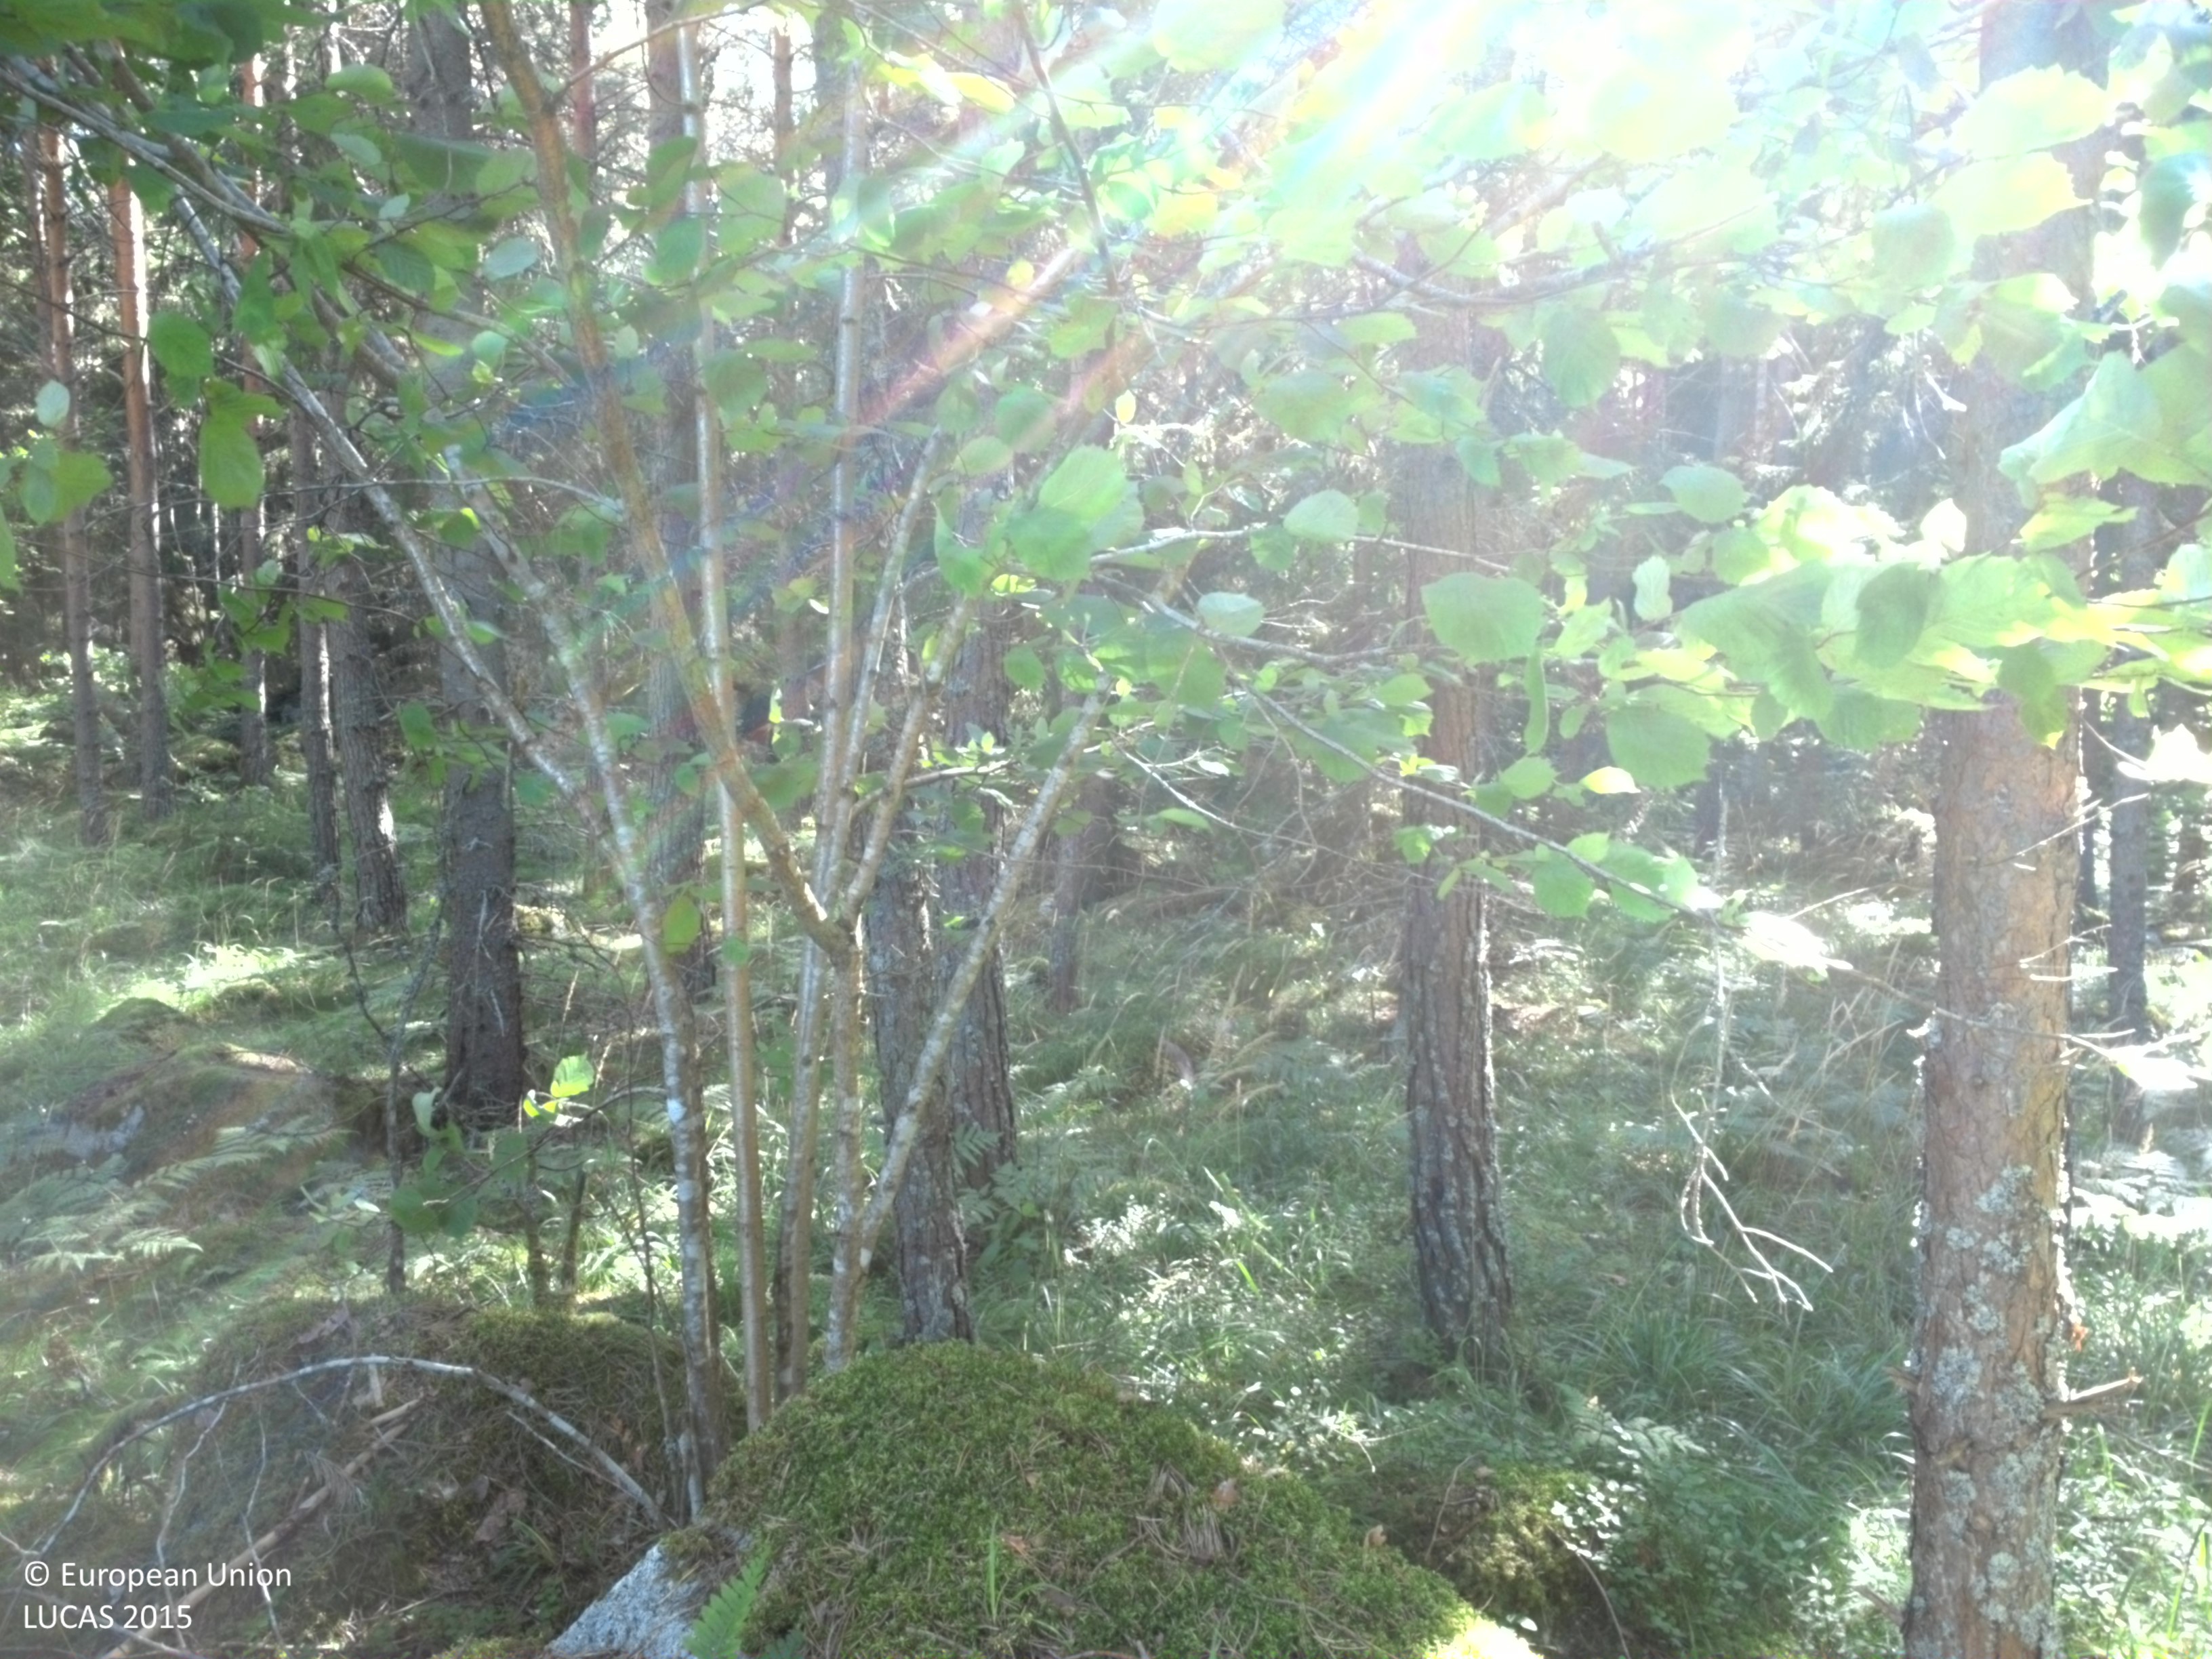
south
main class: Woodland
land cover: Pine dominated coniferous woodland
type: boreal forest
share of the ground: > 75 %
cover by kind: coniferous forest trees 70 %, shrubs 15 %, broadleaved forest trees 5 %, herbaceous plants 5 %, lichens and mosses 5 %
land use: Forestry
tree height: > 5 m
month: August
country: SE
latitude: 59.9713
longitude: 18.0032
